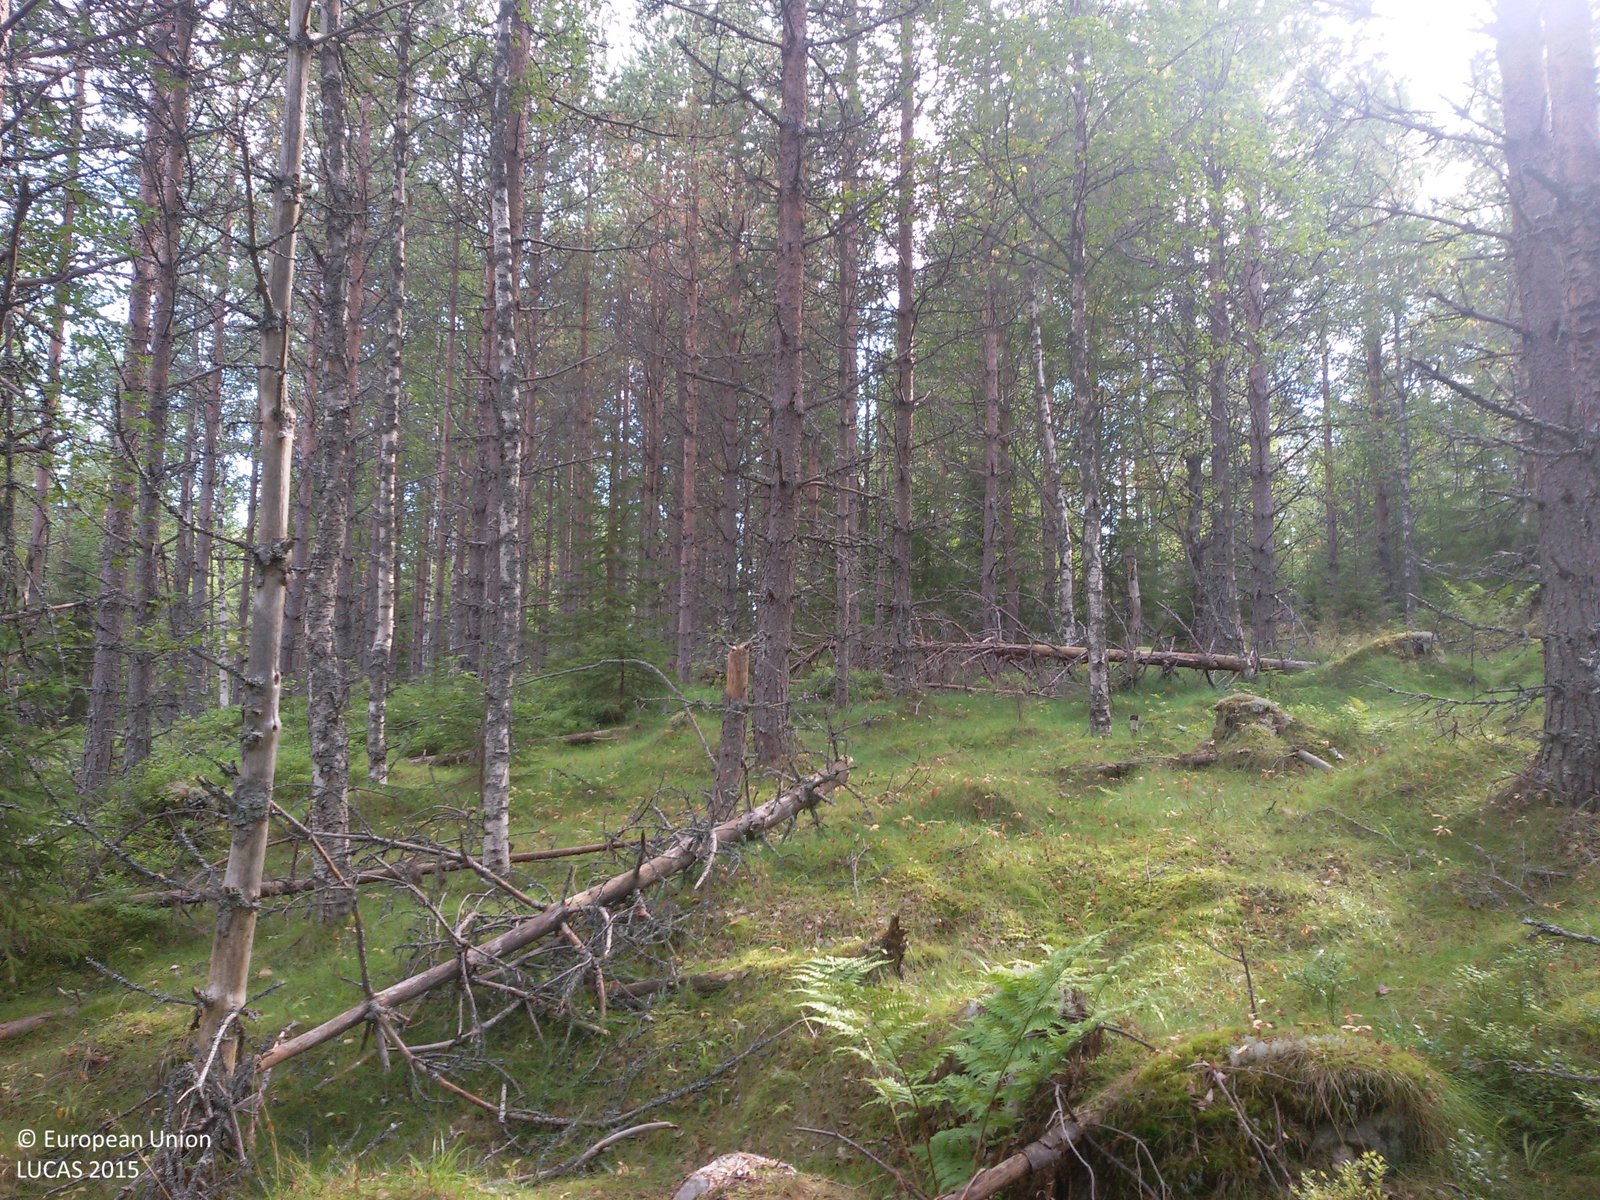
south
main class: Woodland
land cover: Pine dominated mixed woodland
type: boreal forest
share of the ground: > 75 %
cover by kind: coniferous forest trees 50 %, broadleaved forest trees 25 %, herbaceous plants 15 %, lichens and mosses 10 %
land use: Forestry
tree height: > 5 m
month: August
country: SE
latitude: 60.8640
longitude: 16.0442
